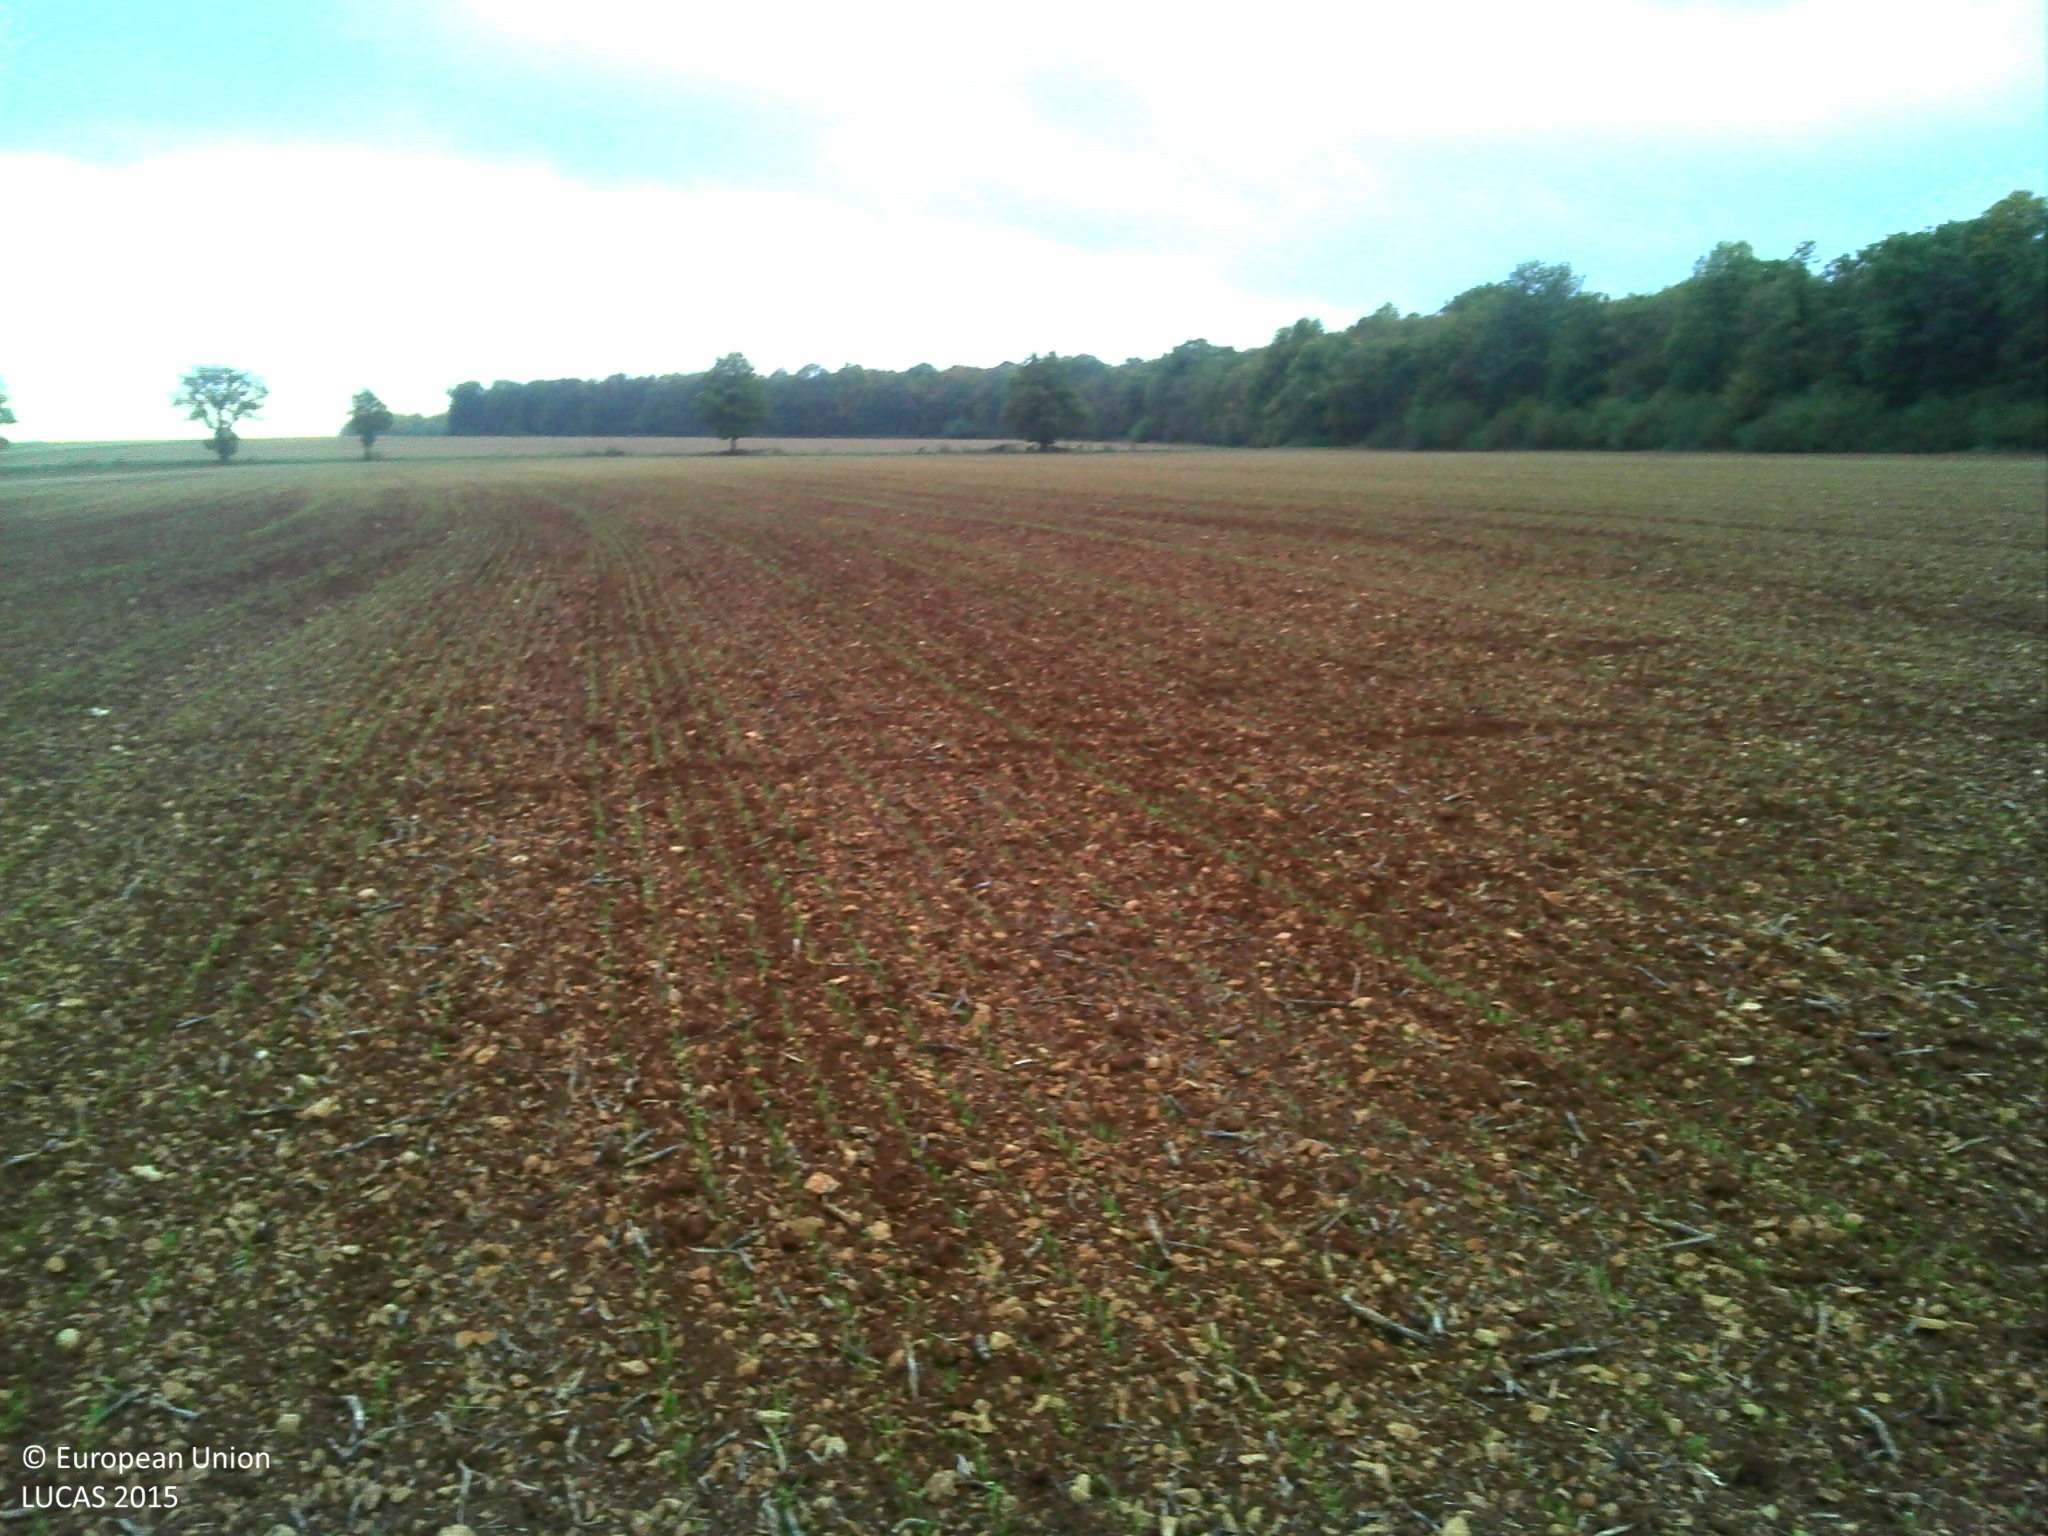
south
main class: Cropland
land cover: Common wheat
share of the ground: < 10 %
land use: Agriculture (excluding fallow land and kitchen gardens)
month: October
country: FR
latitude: 47.5879
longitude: 5.0134
